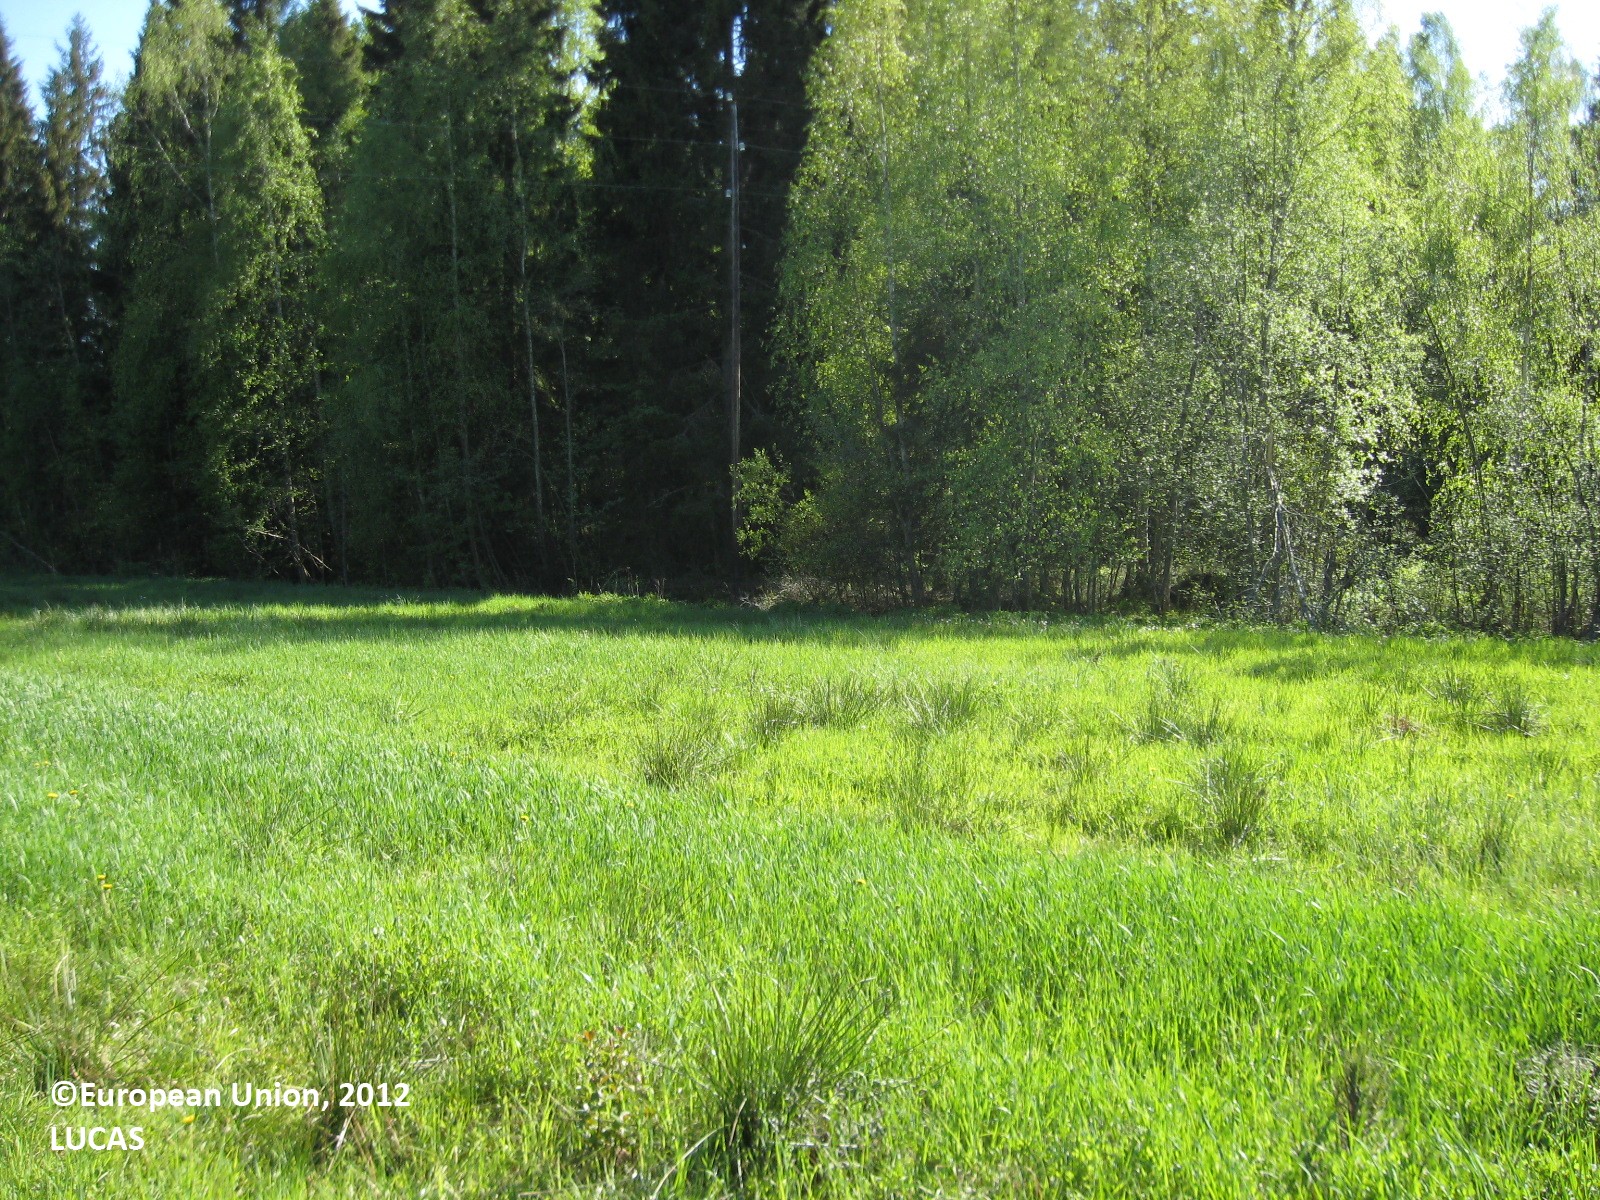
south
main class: Grassland
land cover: Grassland without tree/shrub cover
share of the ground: > 75 %
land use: Agriculture (excluding fallow land and kitchen gardens)
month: May
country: FI
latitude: 61.7686
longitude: 22.3966
